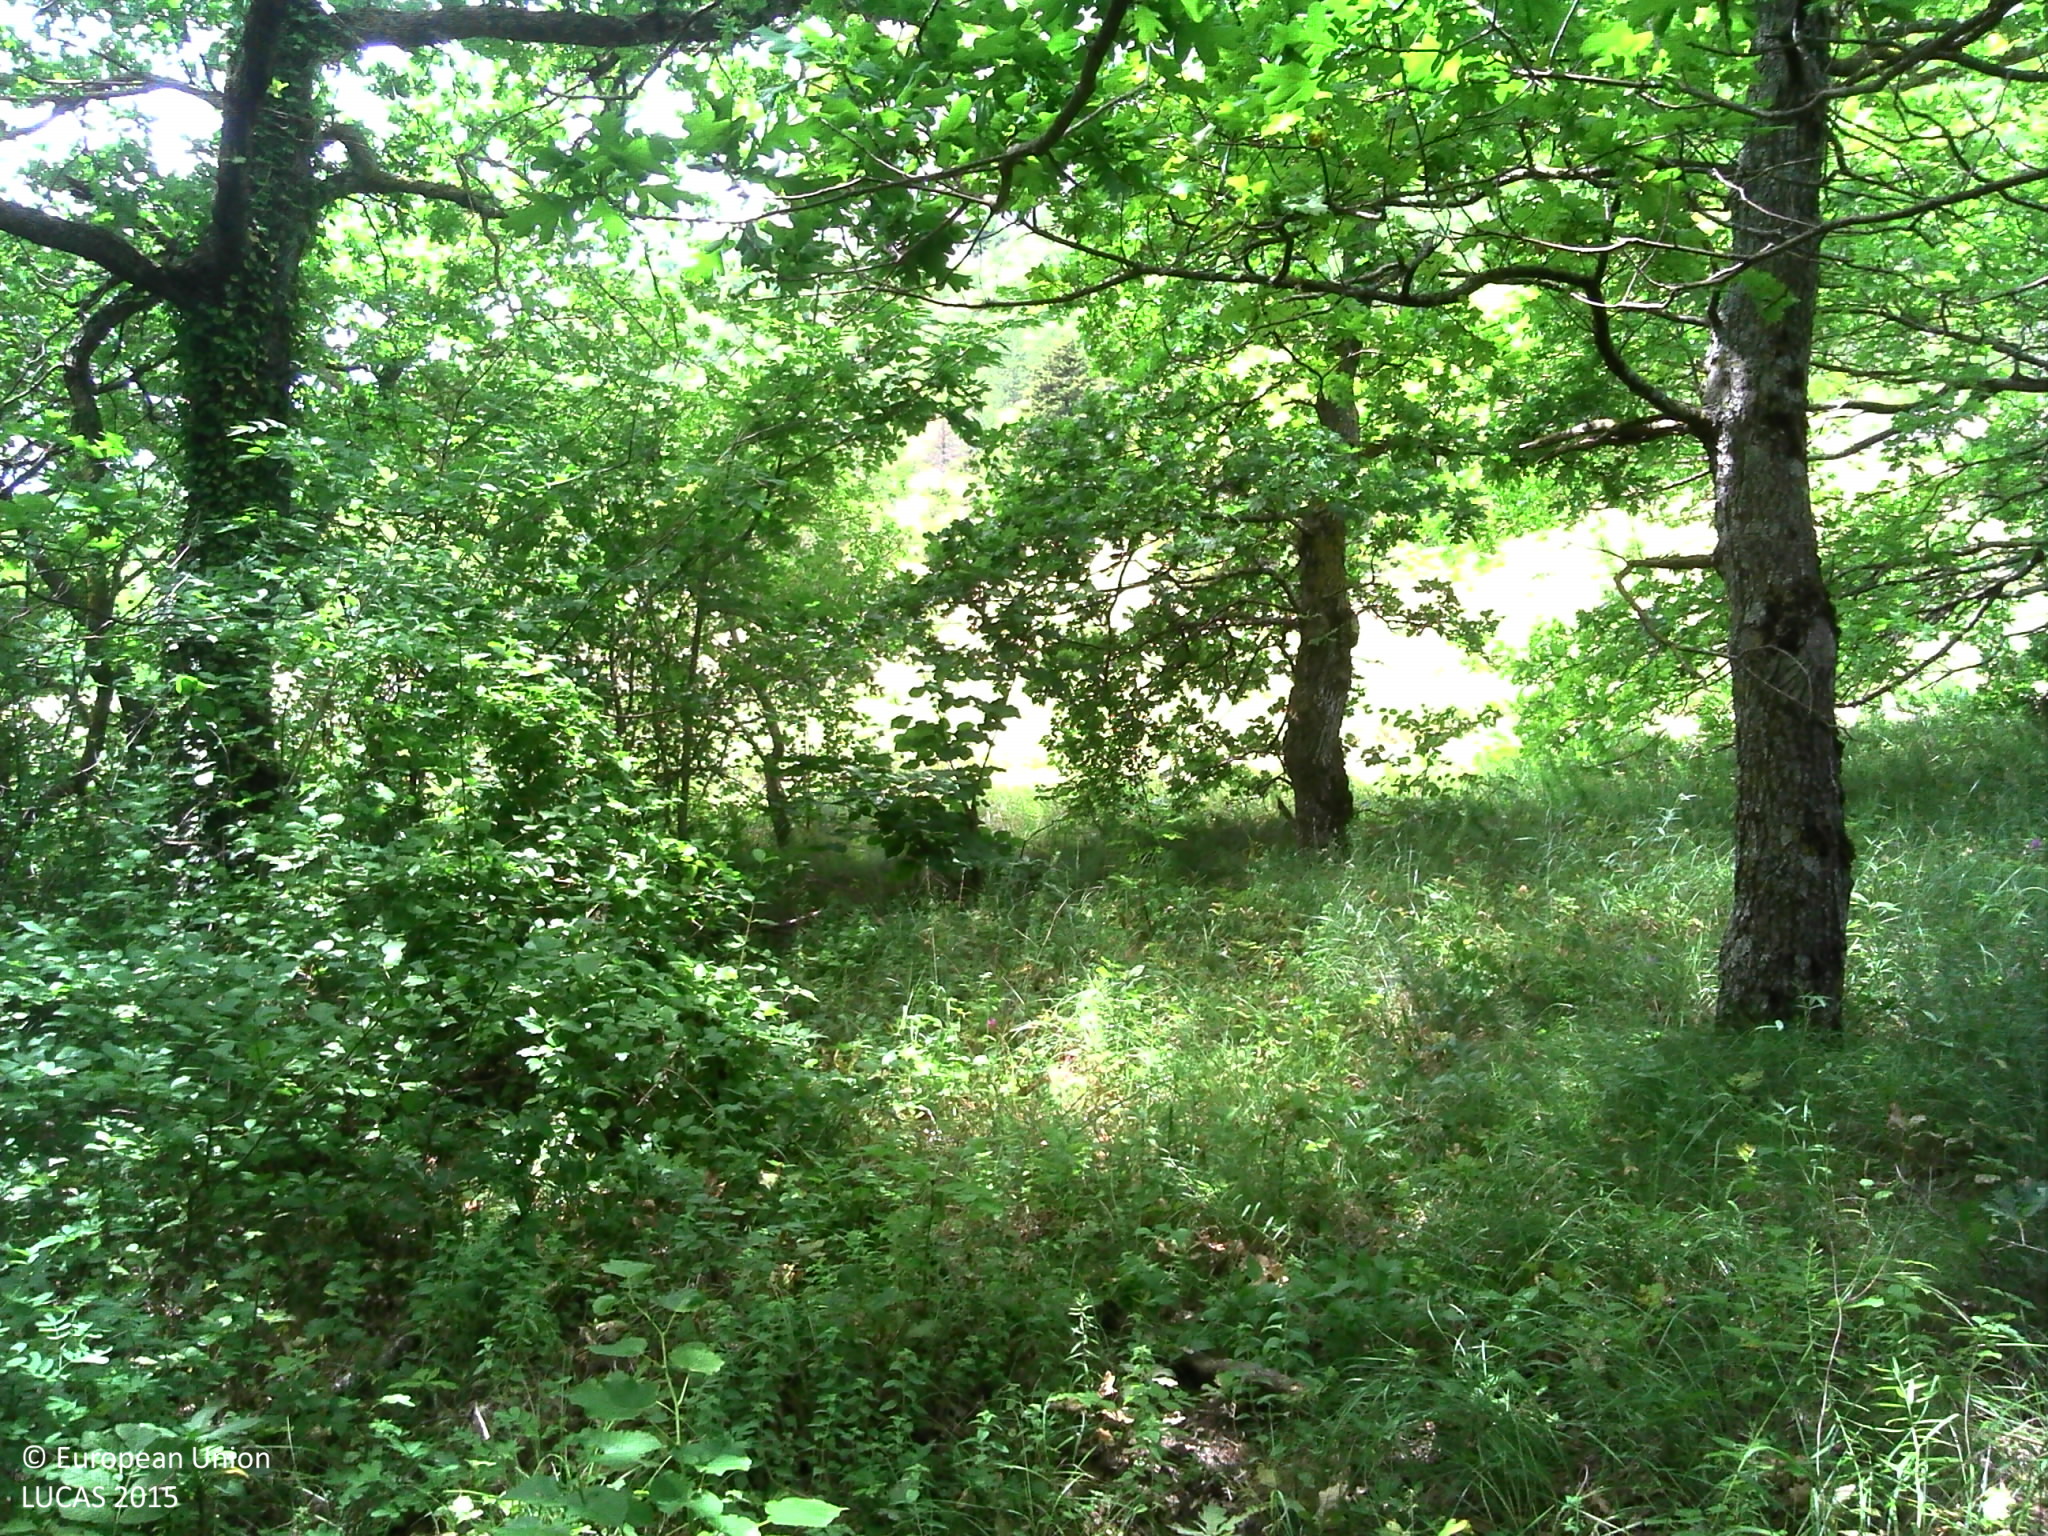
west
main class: Woodland
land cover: Broadleaved woodland
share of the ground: > 75 %
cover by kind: broadleaved forest trees 100 %
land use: Forestry
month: June
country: FR
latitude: 44.6492
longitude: 5.0764
